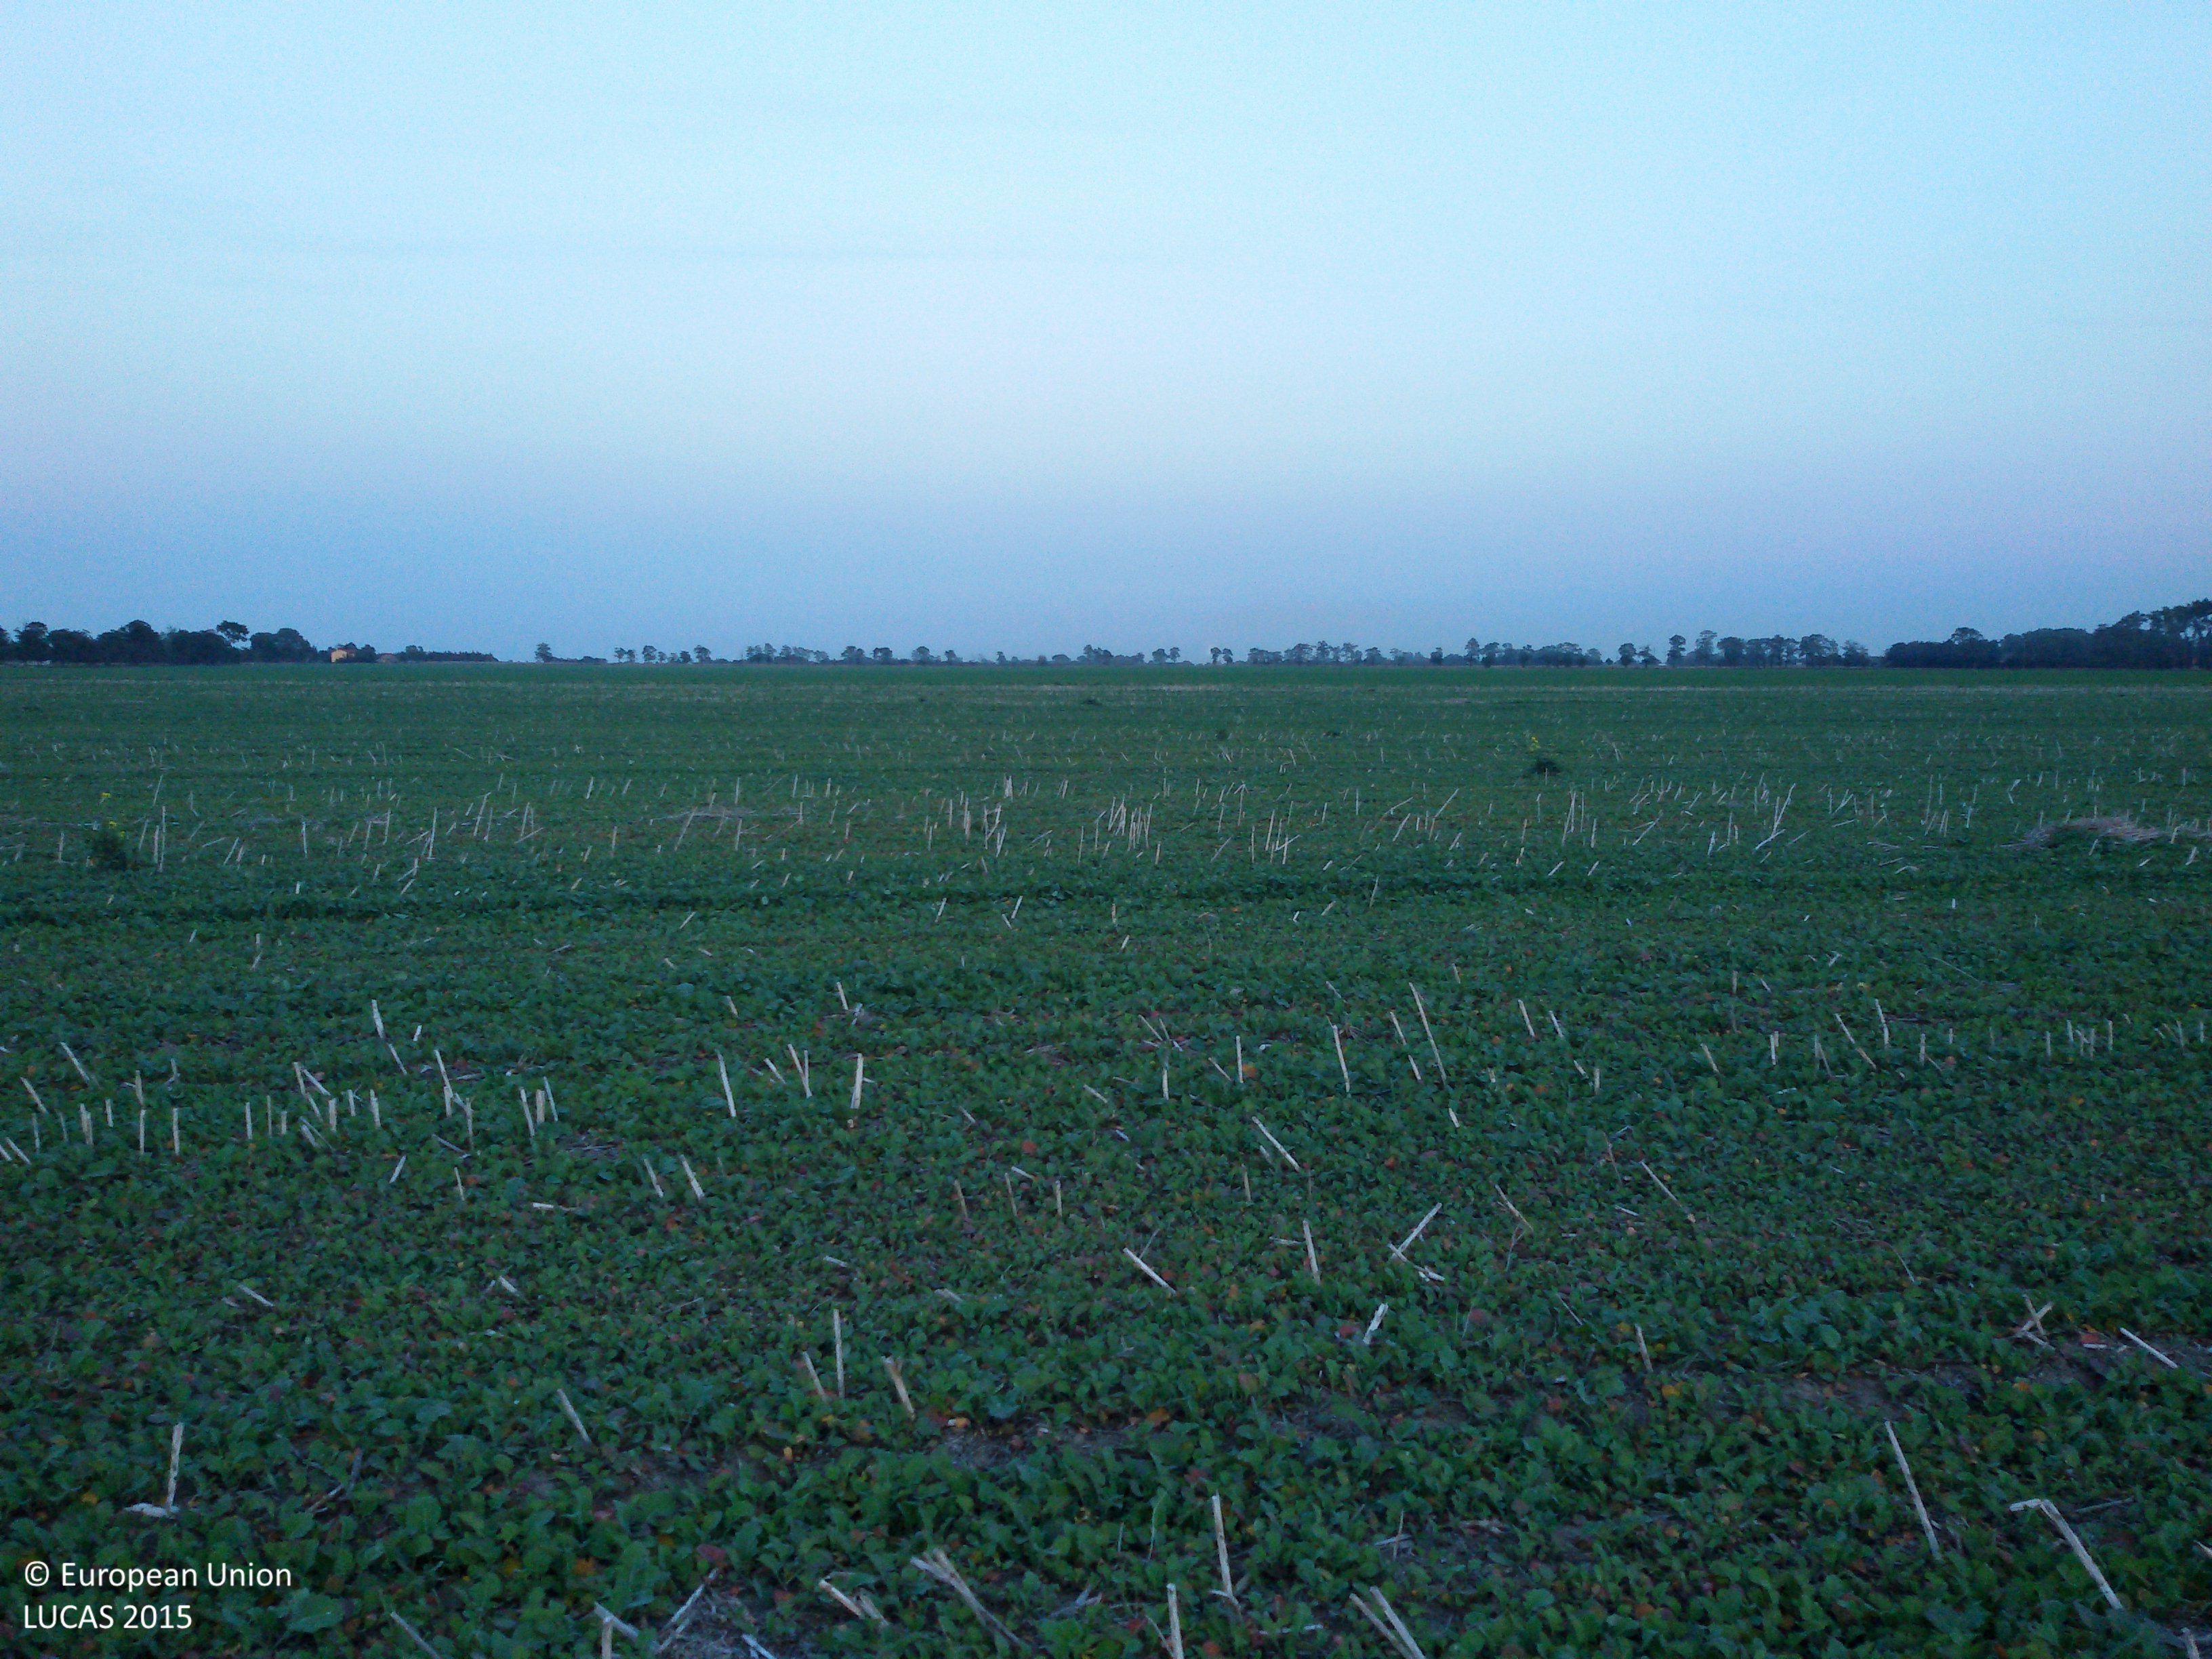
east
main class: Cropland
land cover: Rape and turnip rape
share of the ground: > 75 %
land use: Agriculture (excluding fallow land and kitchen gardens)
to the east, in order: Rape and turnip rape
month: September
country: PL
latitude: 52.3609
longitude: 17.9892
